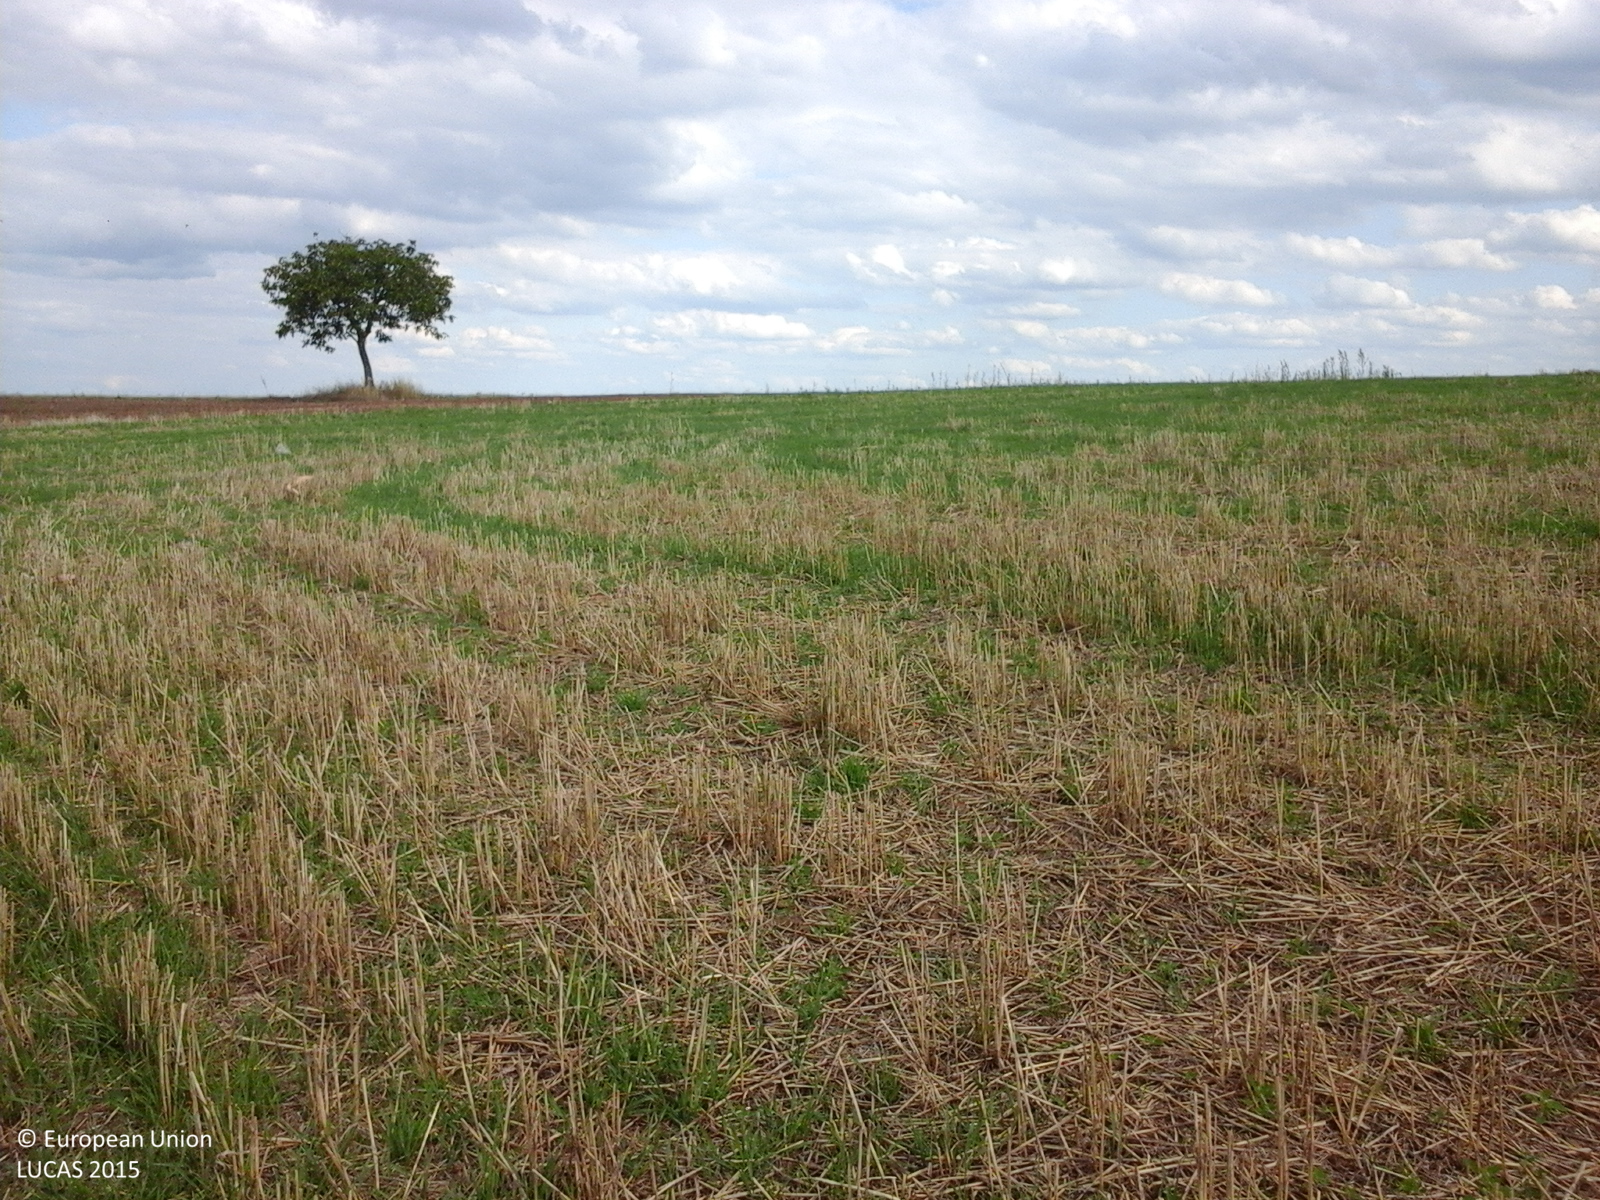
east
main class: Cropland
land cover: Common wheat
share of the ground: 50 - 75 %
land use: Agriculture (excluding fallow land and kitchen gardens)
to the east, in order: Common wheat; Grass margins; Tracks; Grassland without tree/shrub cover; Tracks; Grassland without tree/shrub cover
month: September
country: RO
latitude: 47.4614
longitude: 22.5942
